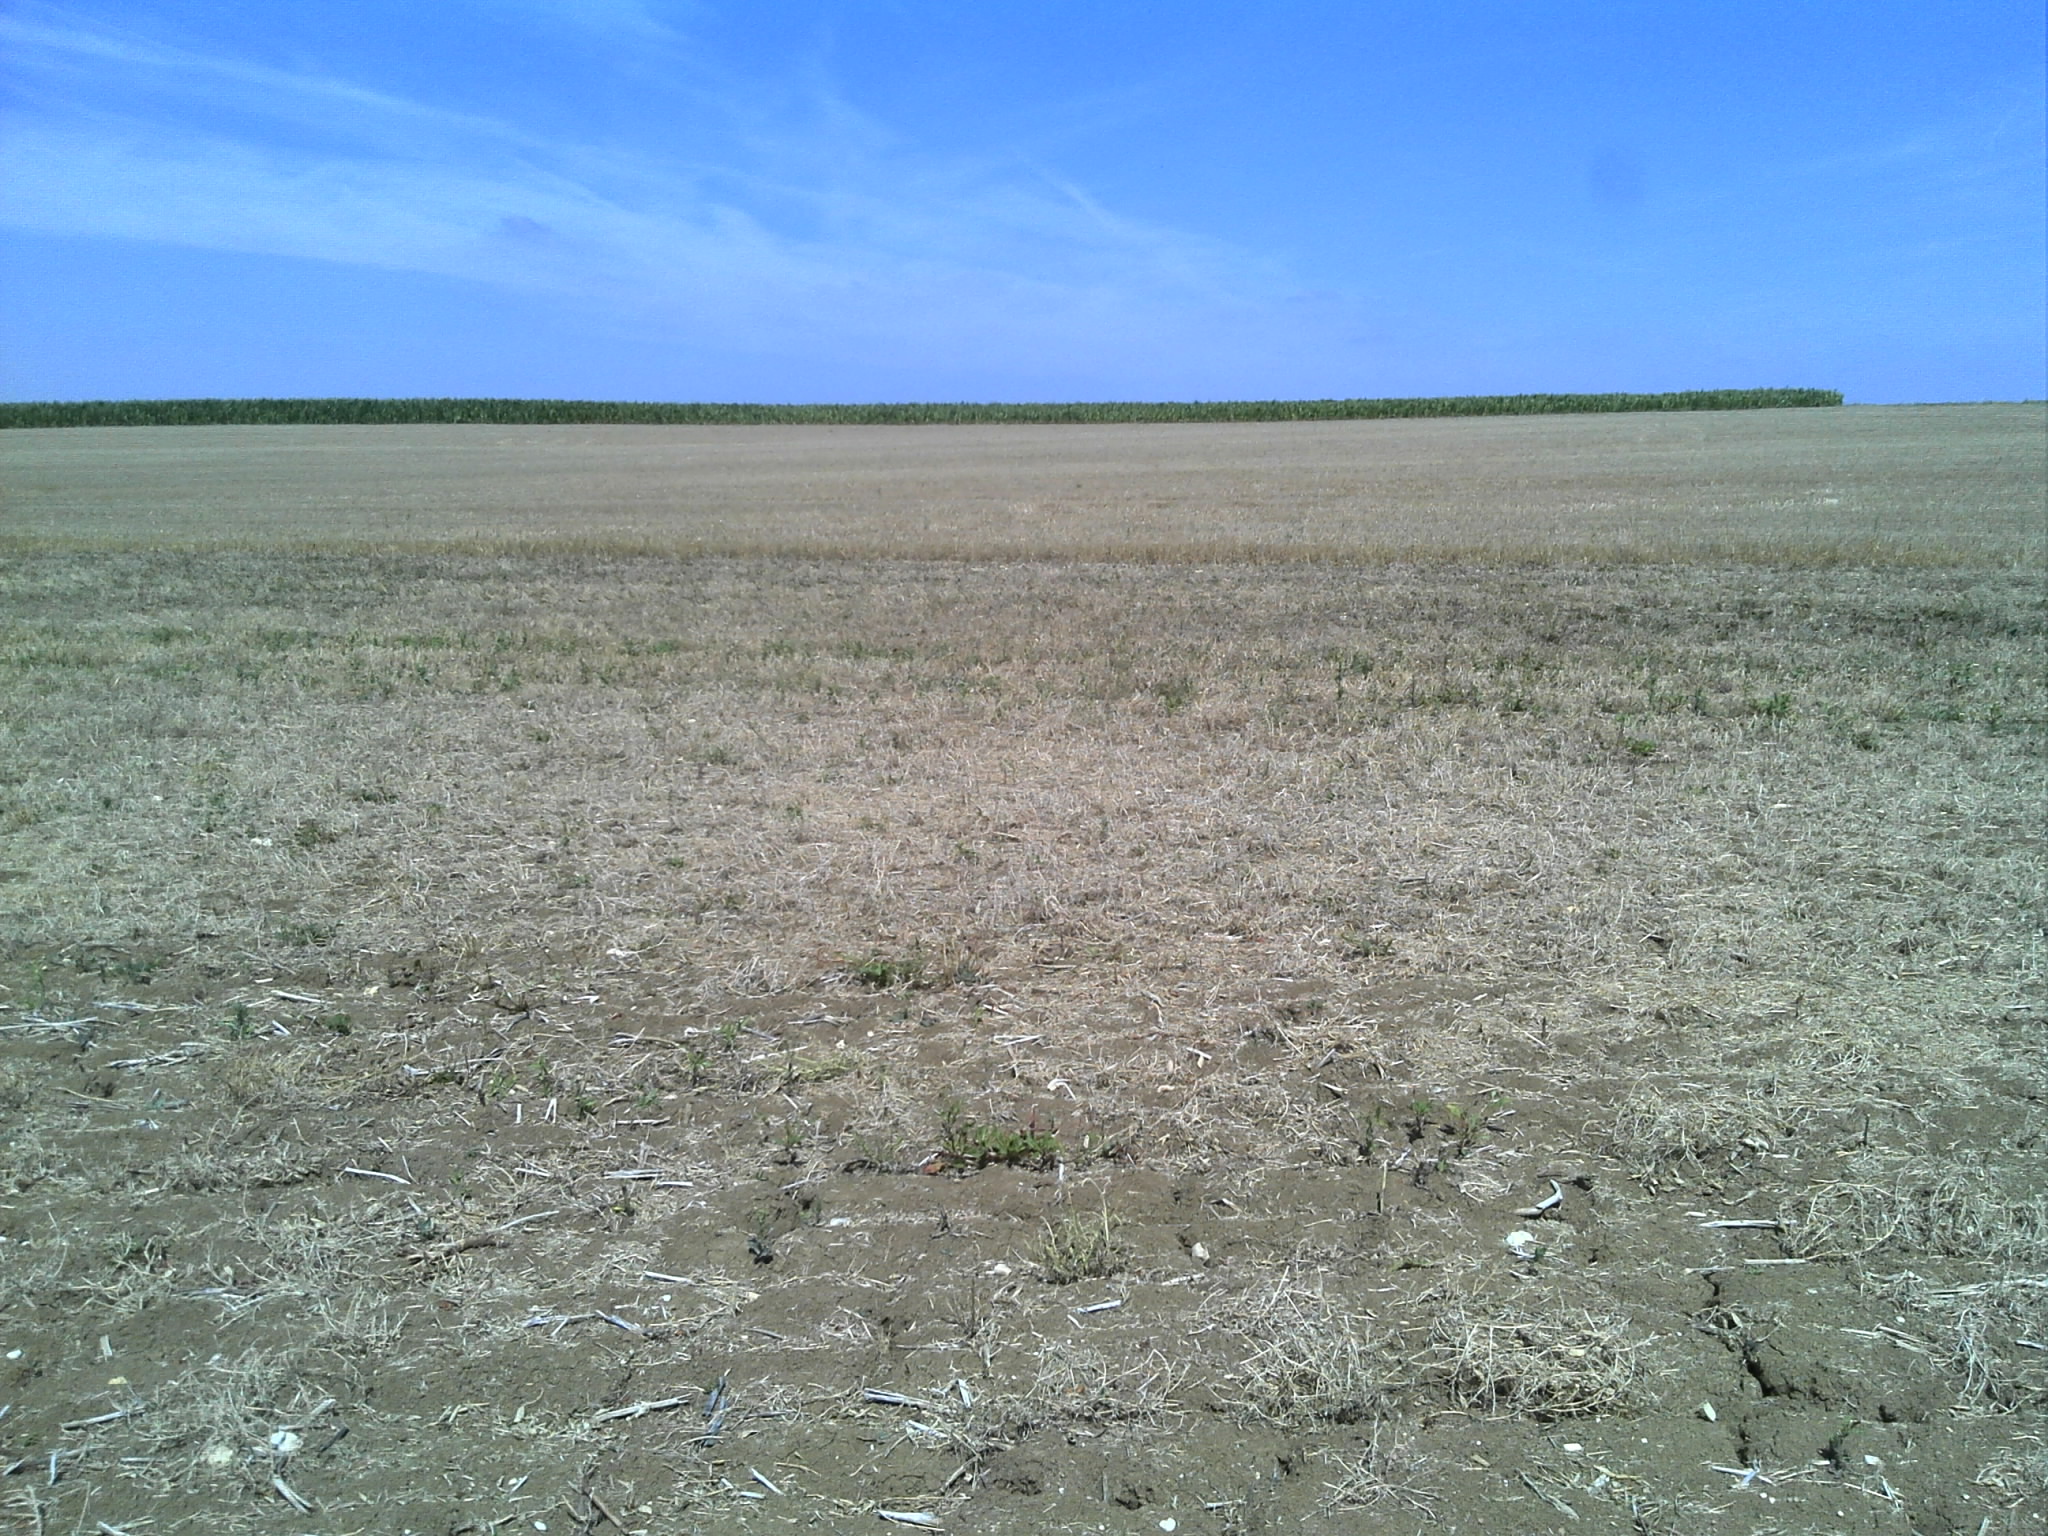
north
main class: Cropland
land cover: Dry pulses
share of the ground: 25 - 50 %
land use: Agriculture (excluding fallow land and kitchen gardens)
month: August
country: FR
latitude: 46.9507
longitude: 1.4605
